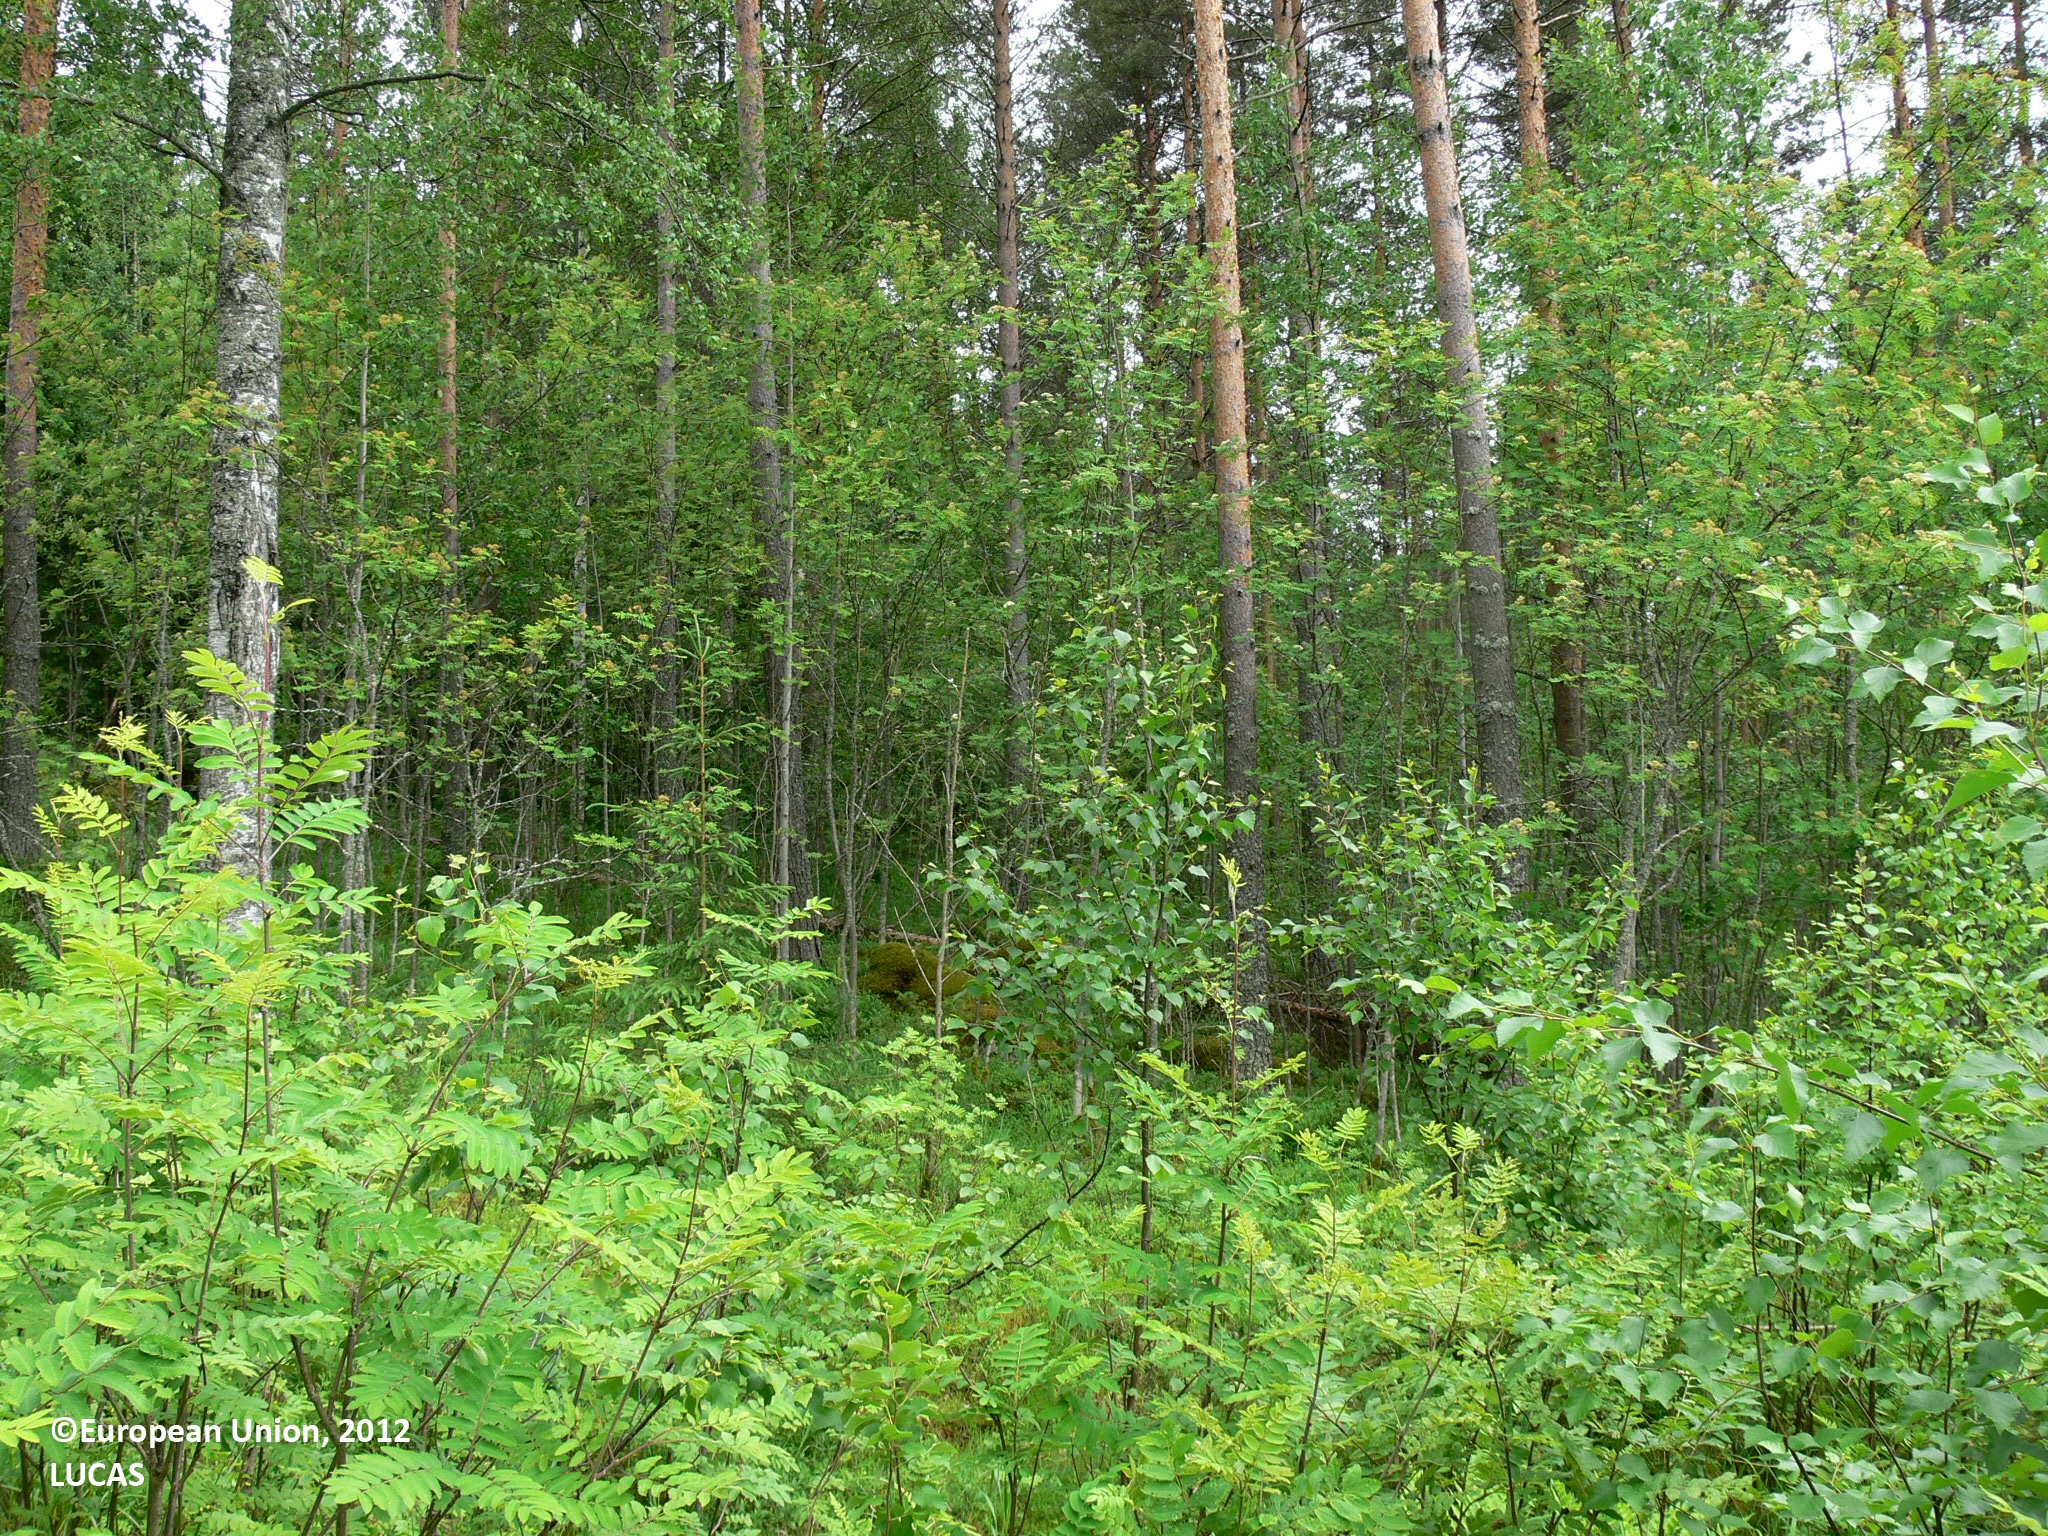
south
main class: Woodland
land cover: Broadleaved woodland
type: boreal forest
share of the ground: > 75 %
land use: Forestry
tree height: < 5 m
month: June
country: FI
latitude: 62.7133
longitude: 29.5366
